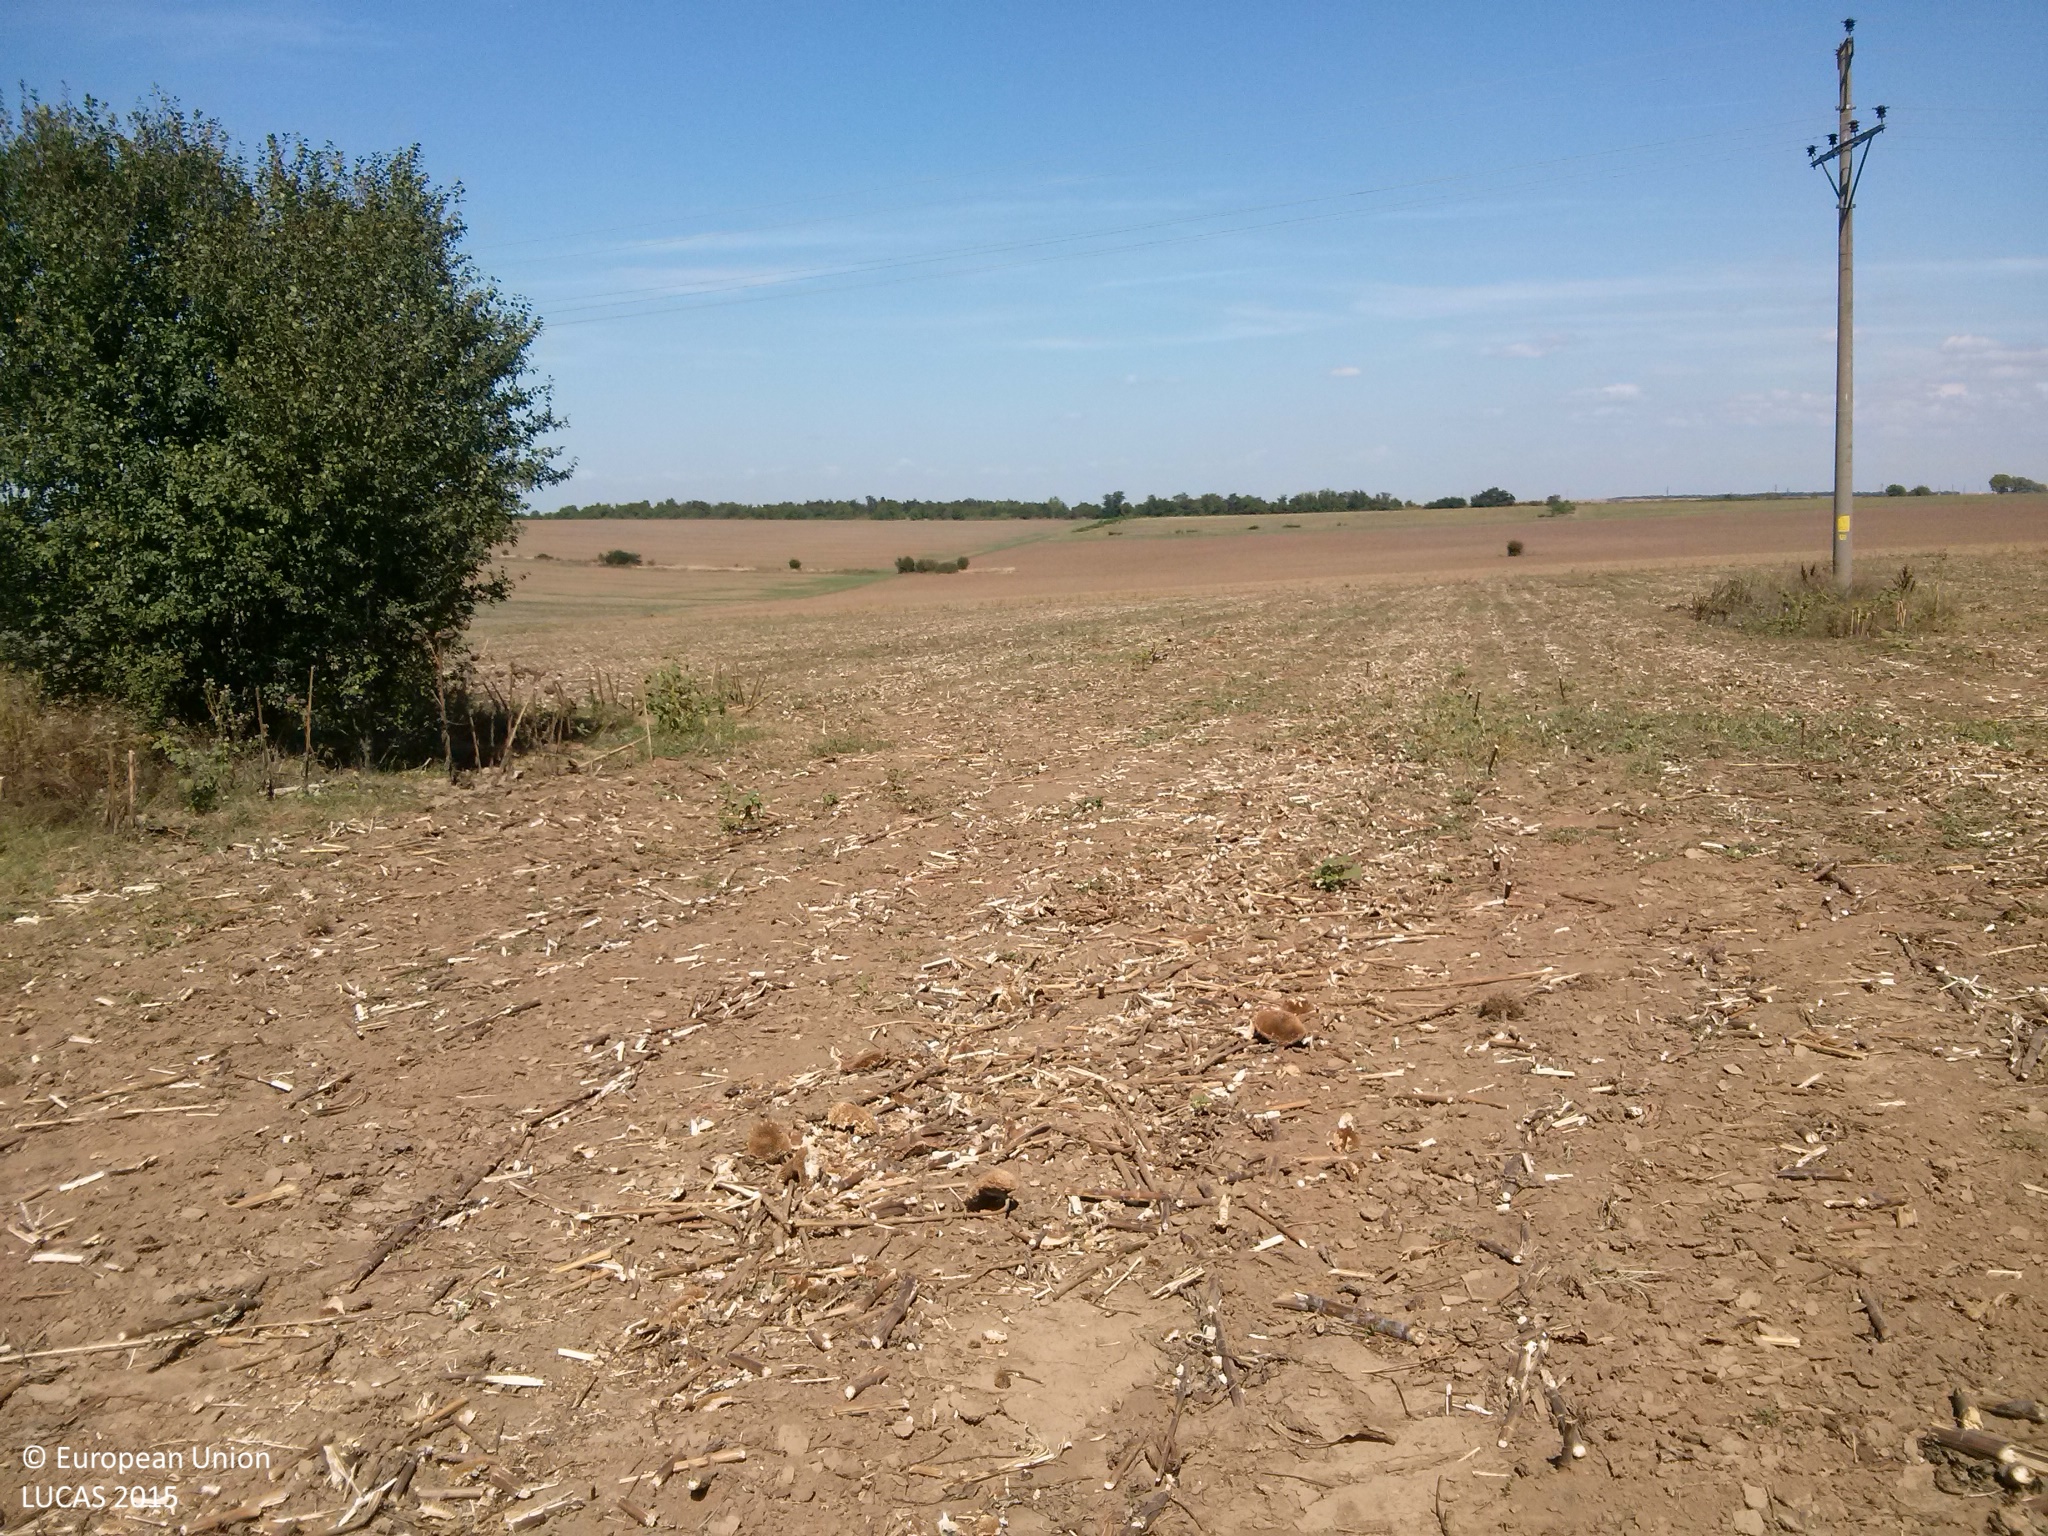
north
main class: Cropland
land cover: Sunflower
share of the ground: < 10 %
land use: Agriculture (excluding fallow land and kitchen gardens)
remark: Harvested field
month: September
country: BG
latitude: 43.6699
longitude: 26.3372
